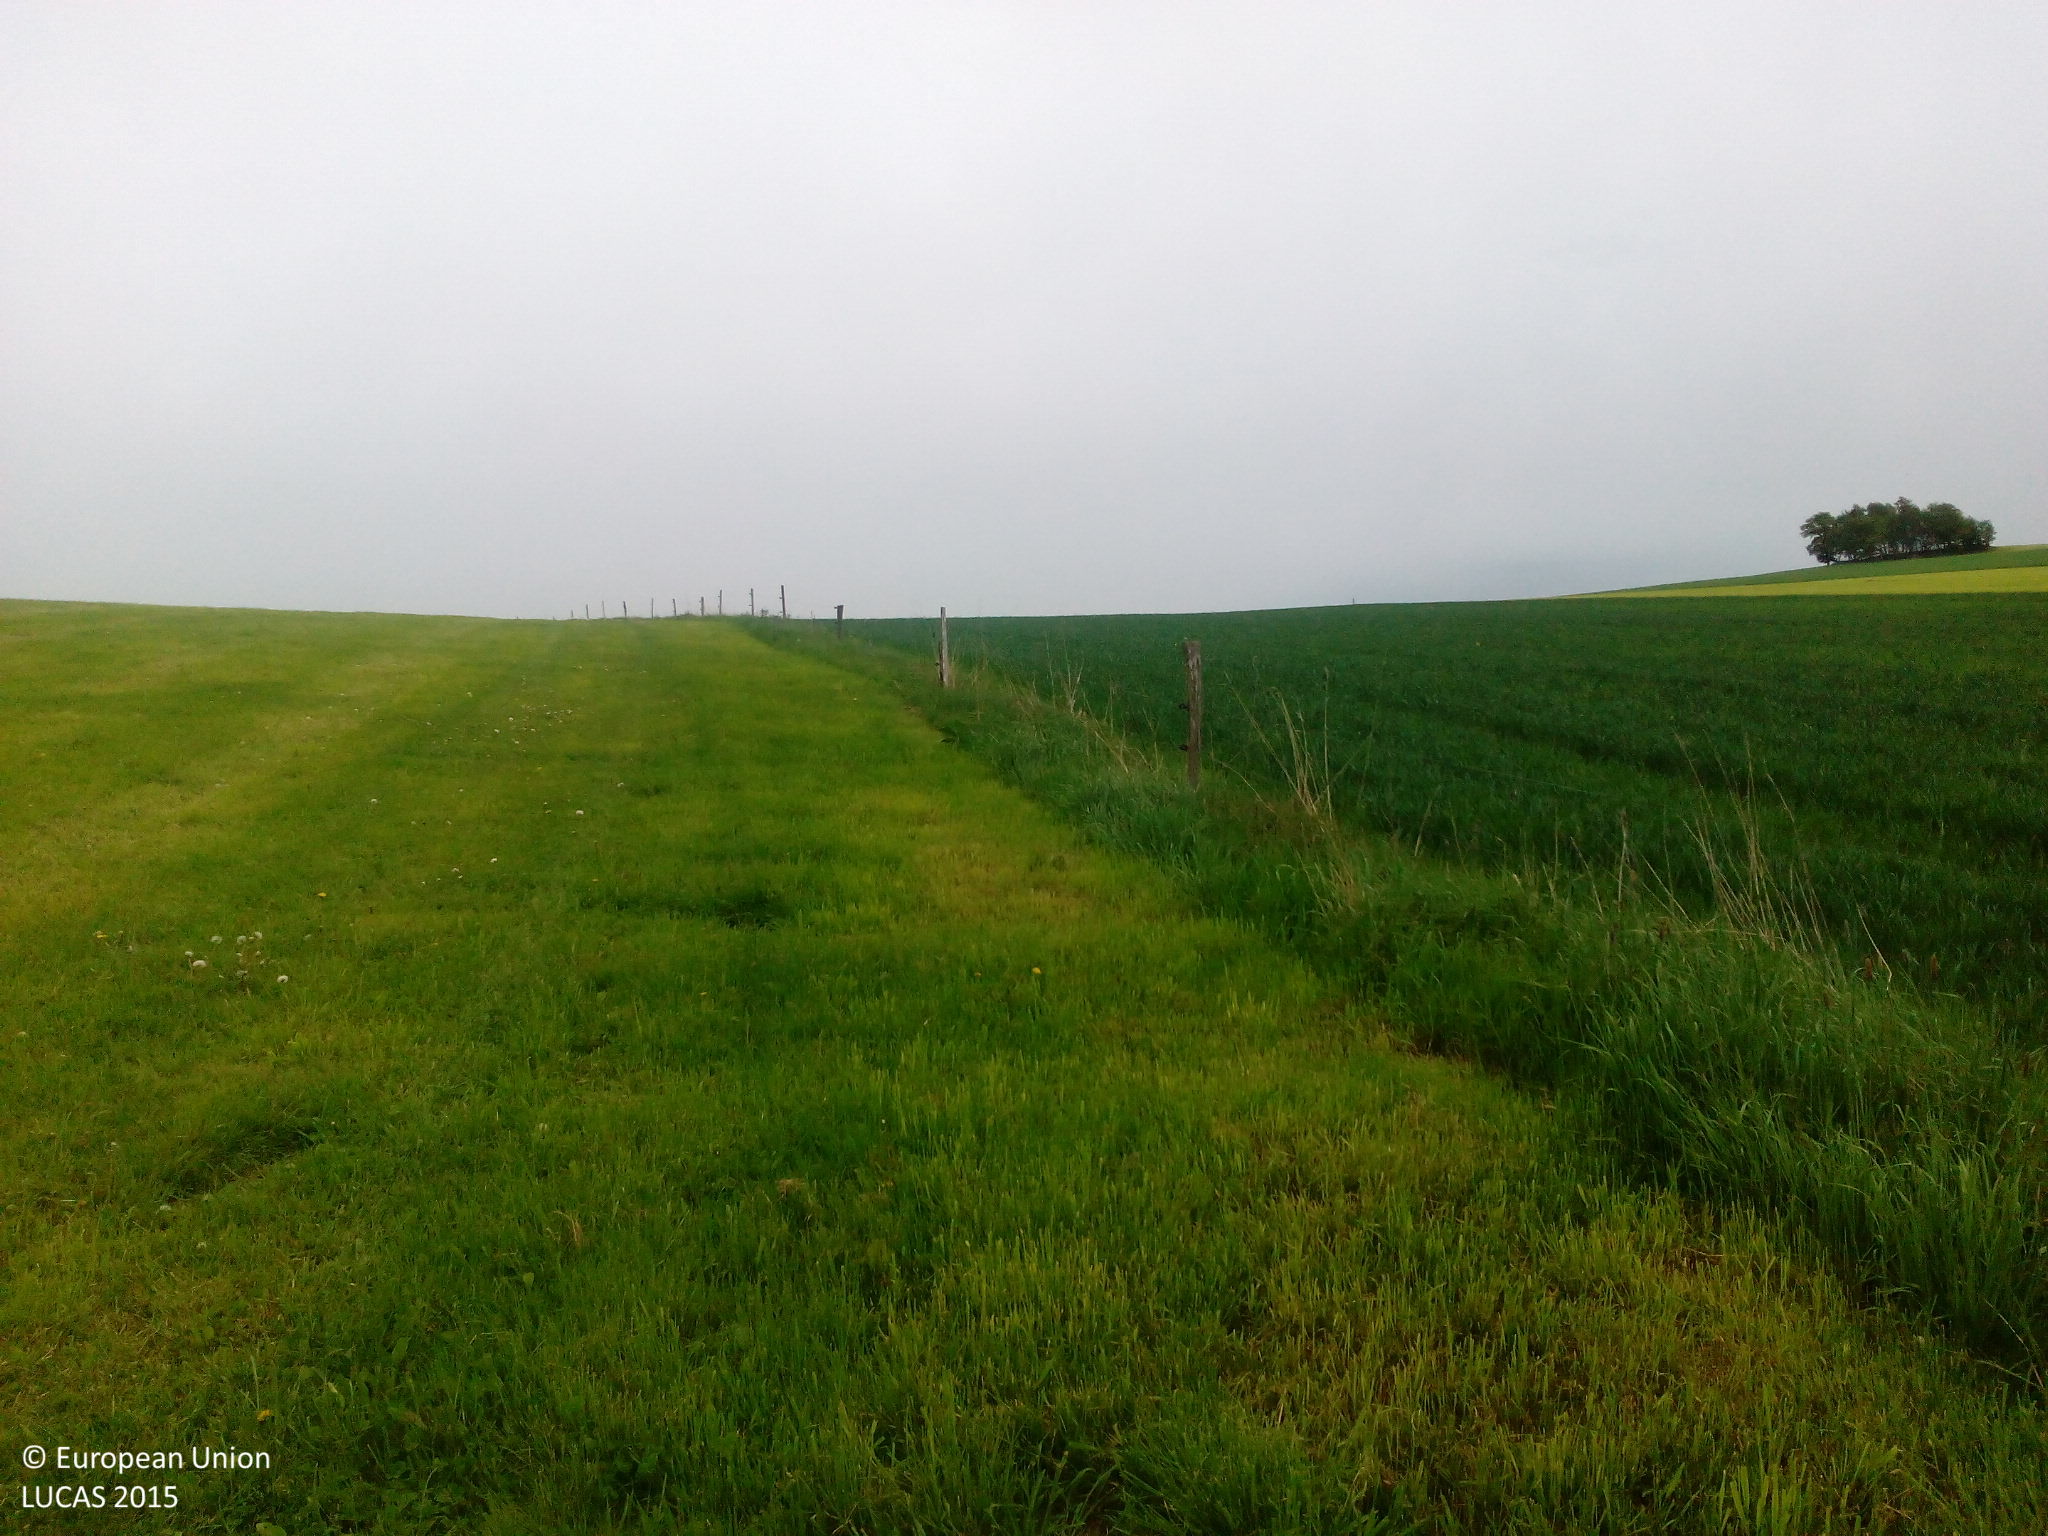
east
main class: Grassland
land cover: Grassland without tree/shrub cover
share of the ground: > 75 %
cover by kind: herbaceous plants 100 %
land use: Agriculture (excluding fallow land and kitchen gardens)
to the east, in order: Grassland without tree/shrub cover; Fences; Triticale; Fences; Grassland without tree/shrub cover
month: May
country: DE
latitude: 50.7186
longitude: 13.0737
